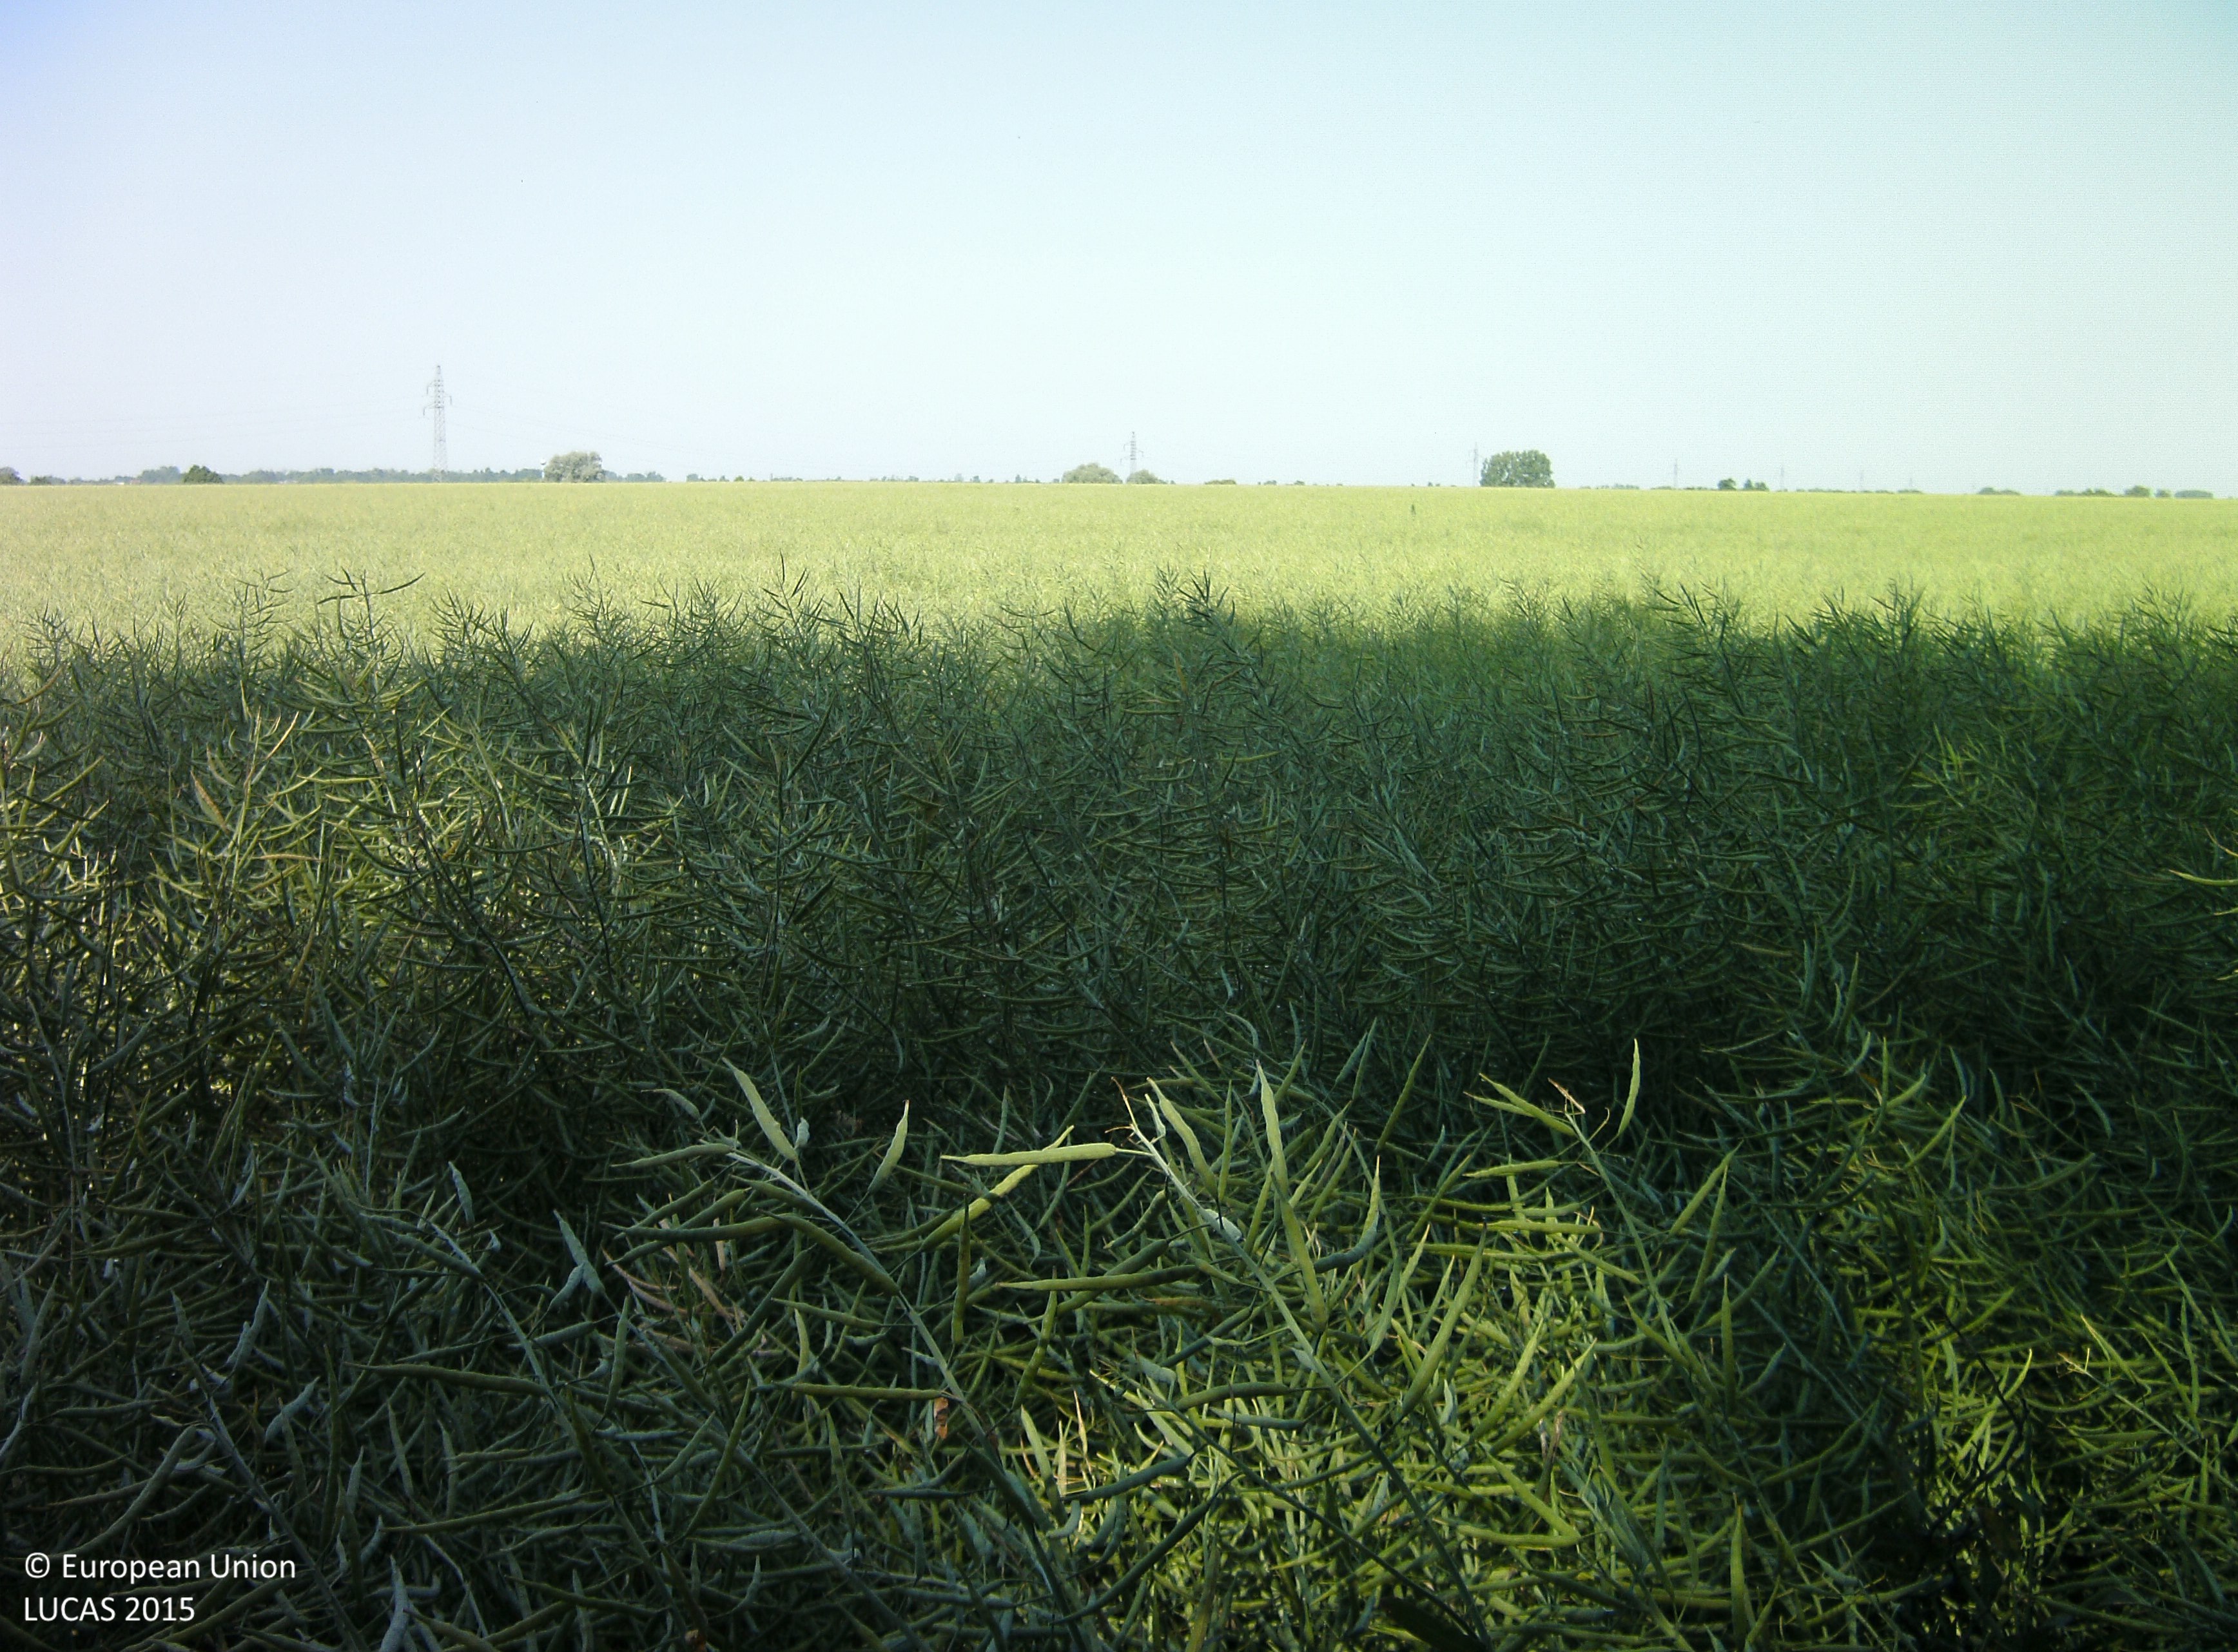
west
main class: Cropland
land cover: Rape and turnip rape
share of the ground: > 75 %
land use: Agriculture (excluding fallow land and kitchen gardens)
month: June
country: HU
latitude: 46.4464
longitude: 18.0392
